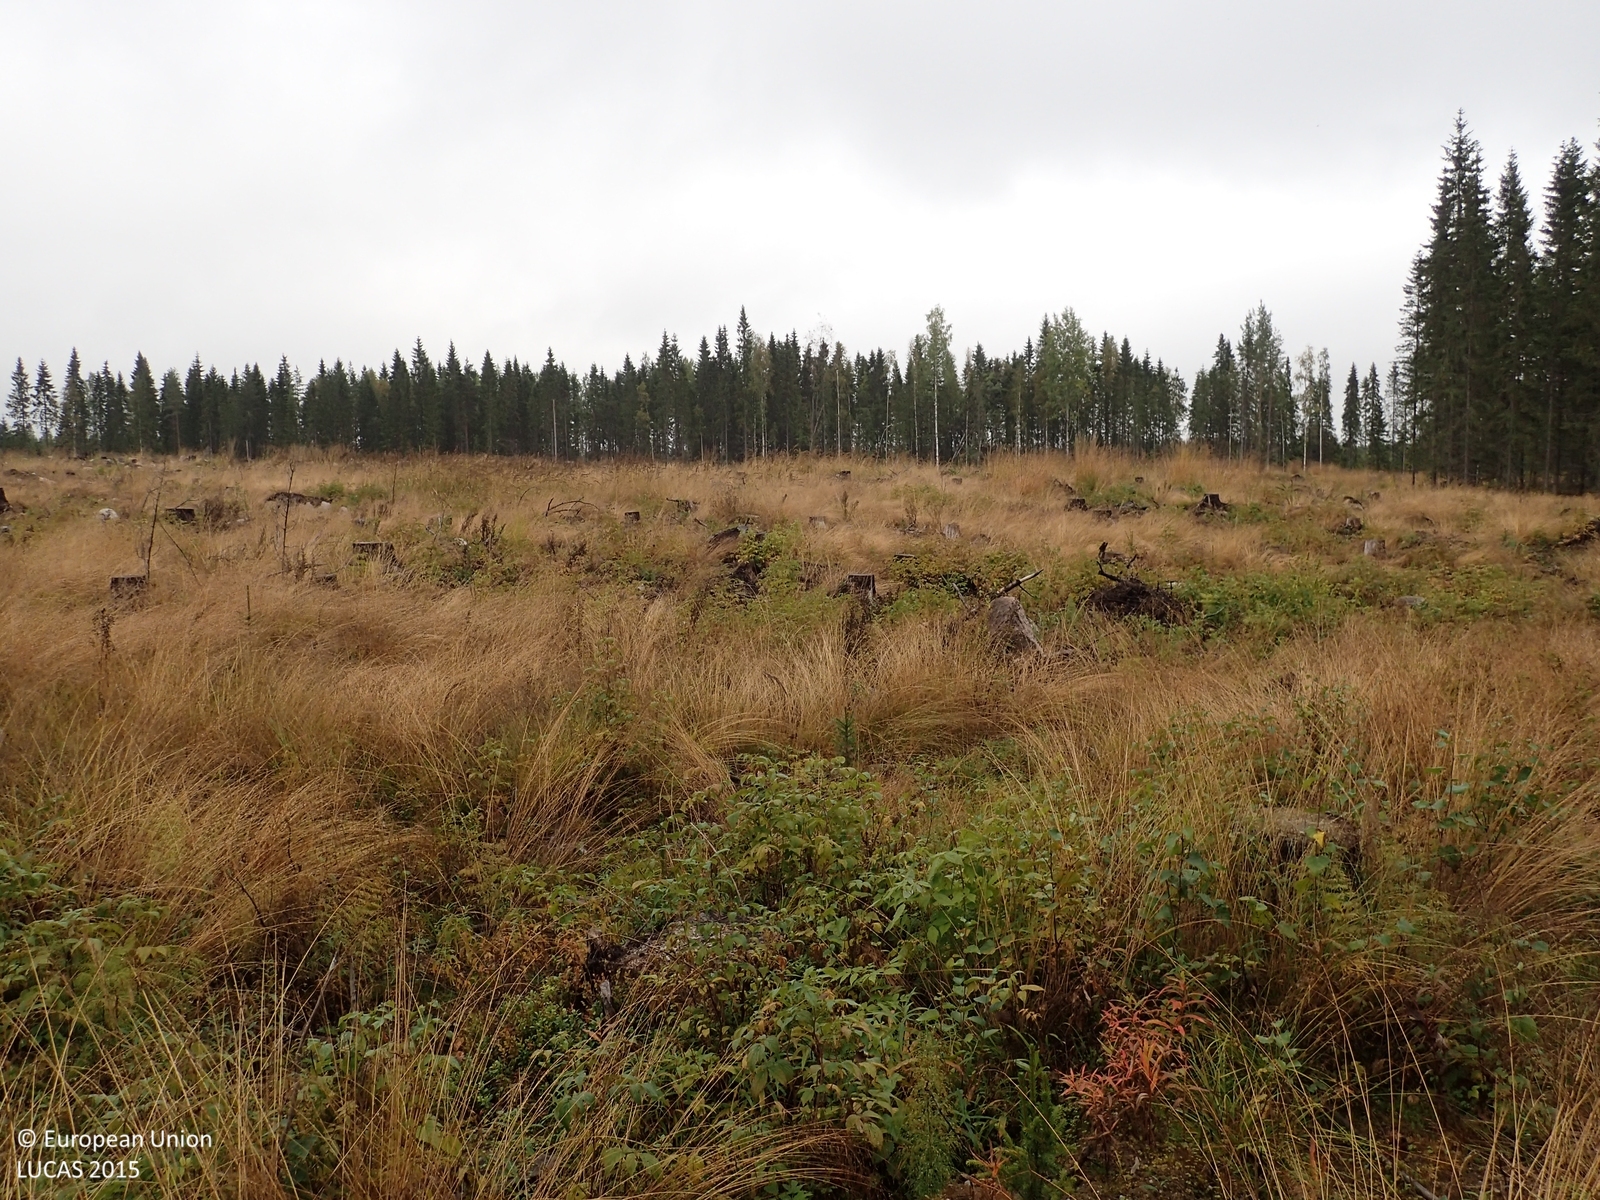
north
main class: Grassland
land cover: Grassland with sparse tree/shrub cover
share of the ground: > 75 %
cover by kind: herbaceous plants 85 %, broadleaved forest trees 5 %, shrubs 5 %, consolidated bare surface 5 %
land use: Forestry
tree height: < 5 m
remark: Clear cut
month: September
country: FI
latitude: 63.1970
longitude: 25.7545
